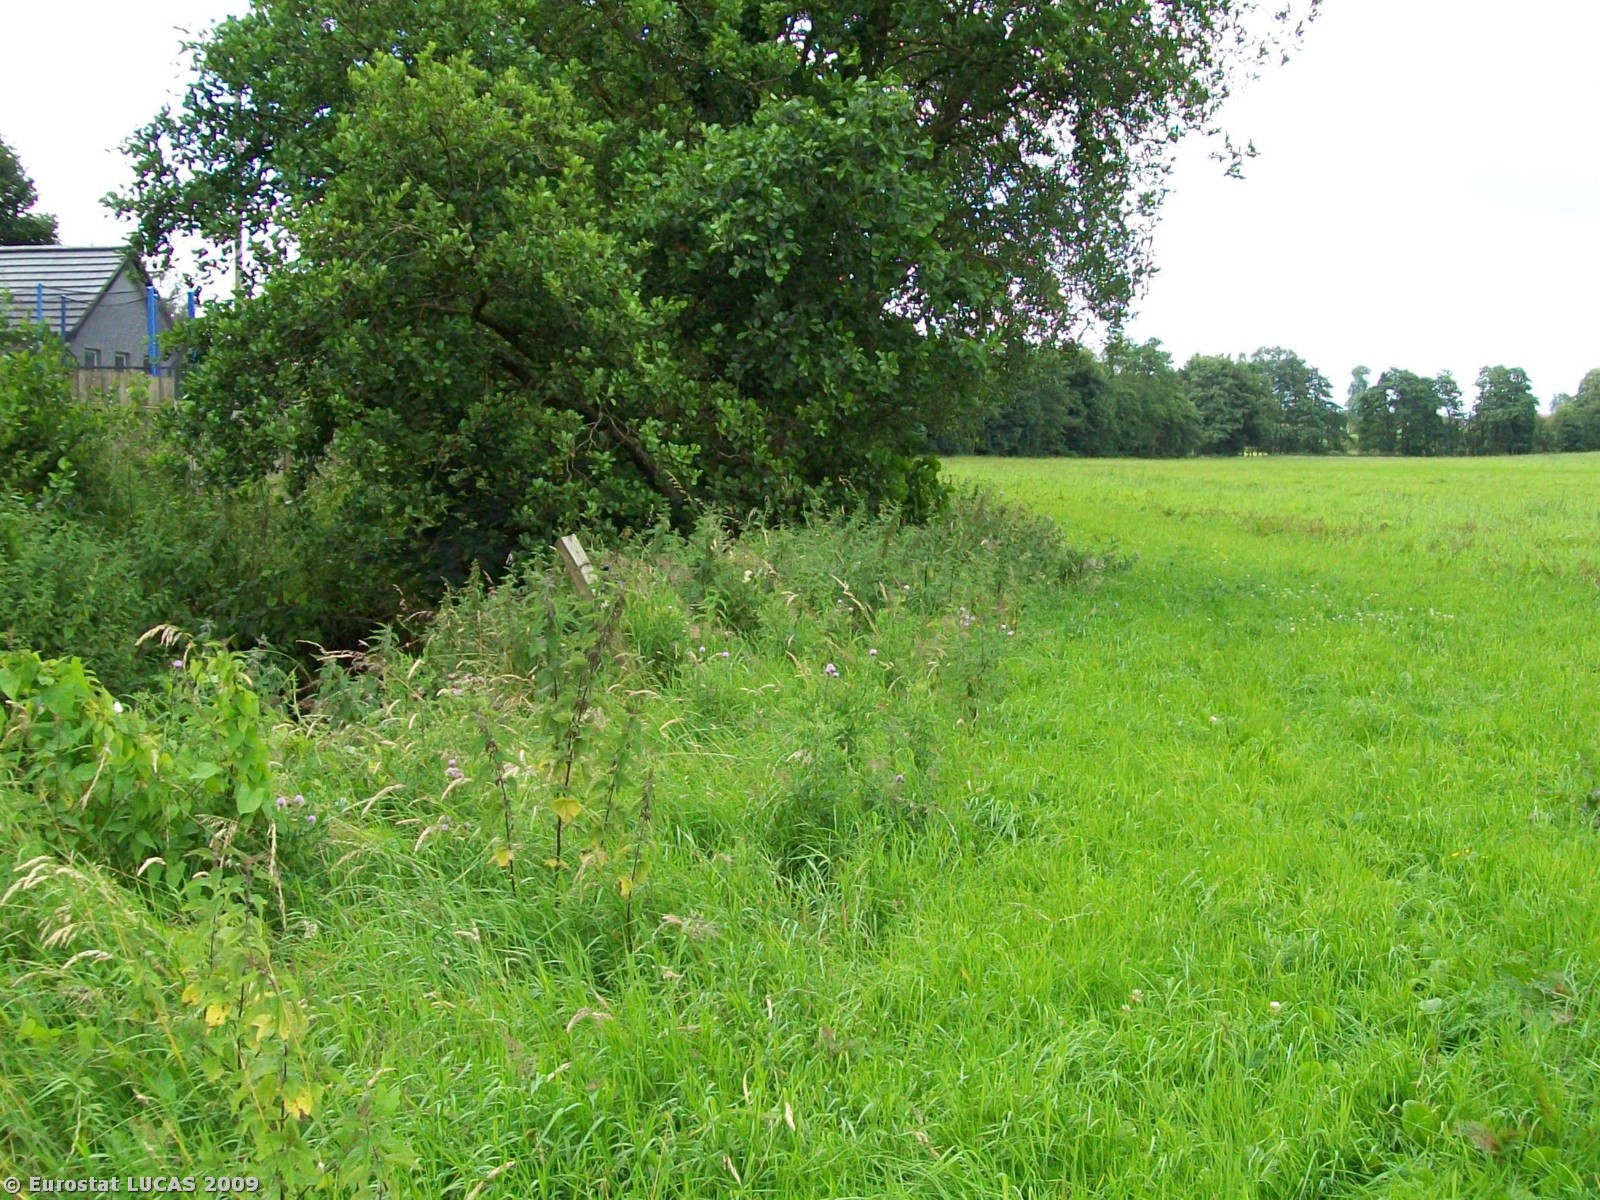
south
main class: Grassland
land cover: Grassland without tree/shrub cover
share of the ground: > 75 %
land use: Agriculture (excluding fallow land and kitchen gardens)
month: July
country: GB
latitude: 54.6272
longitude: -6.6559
